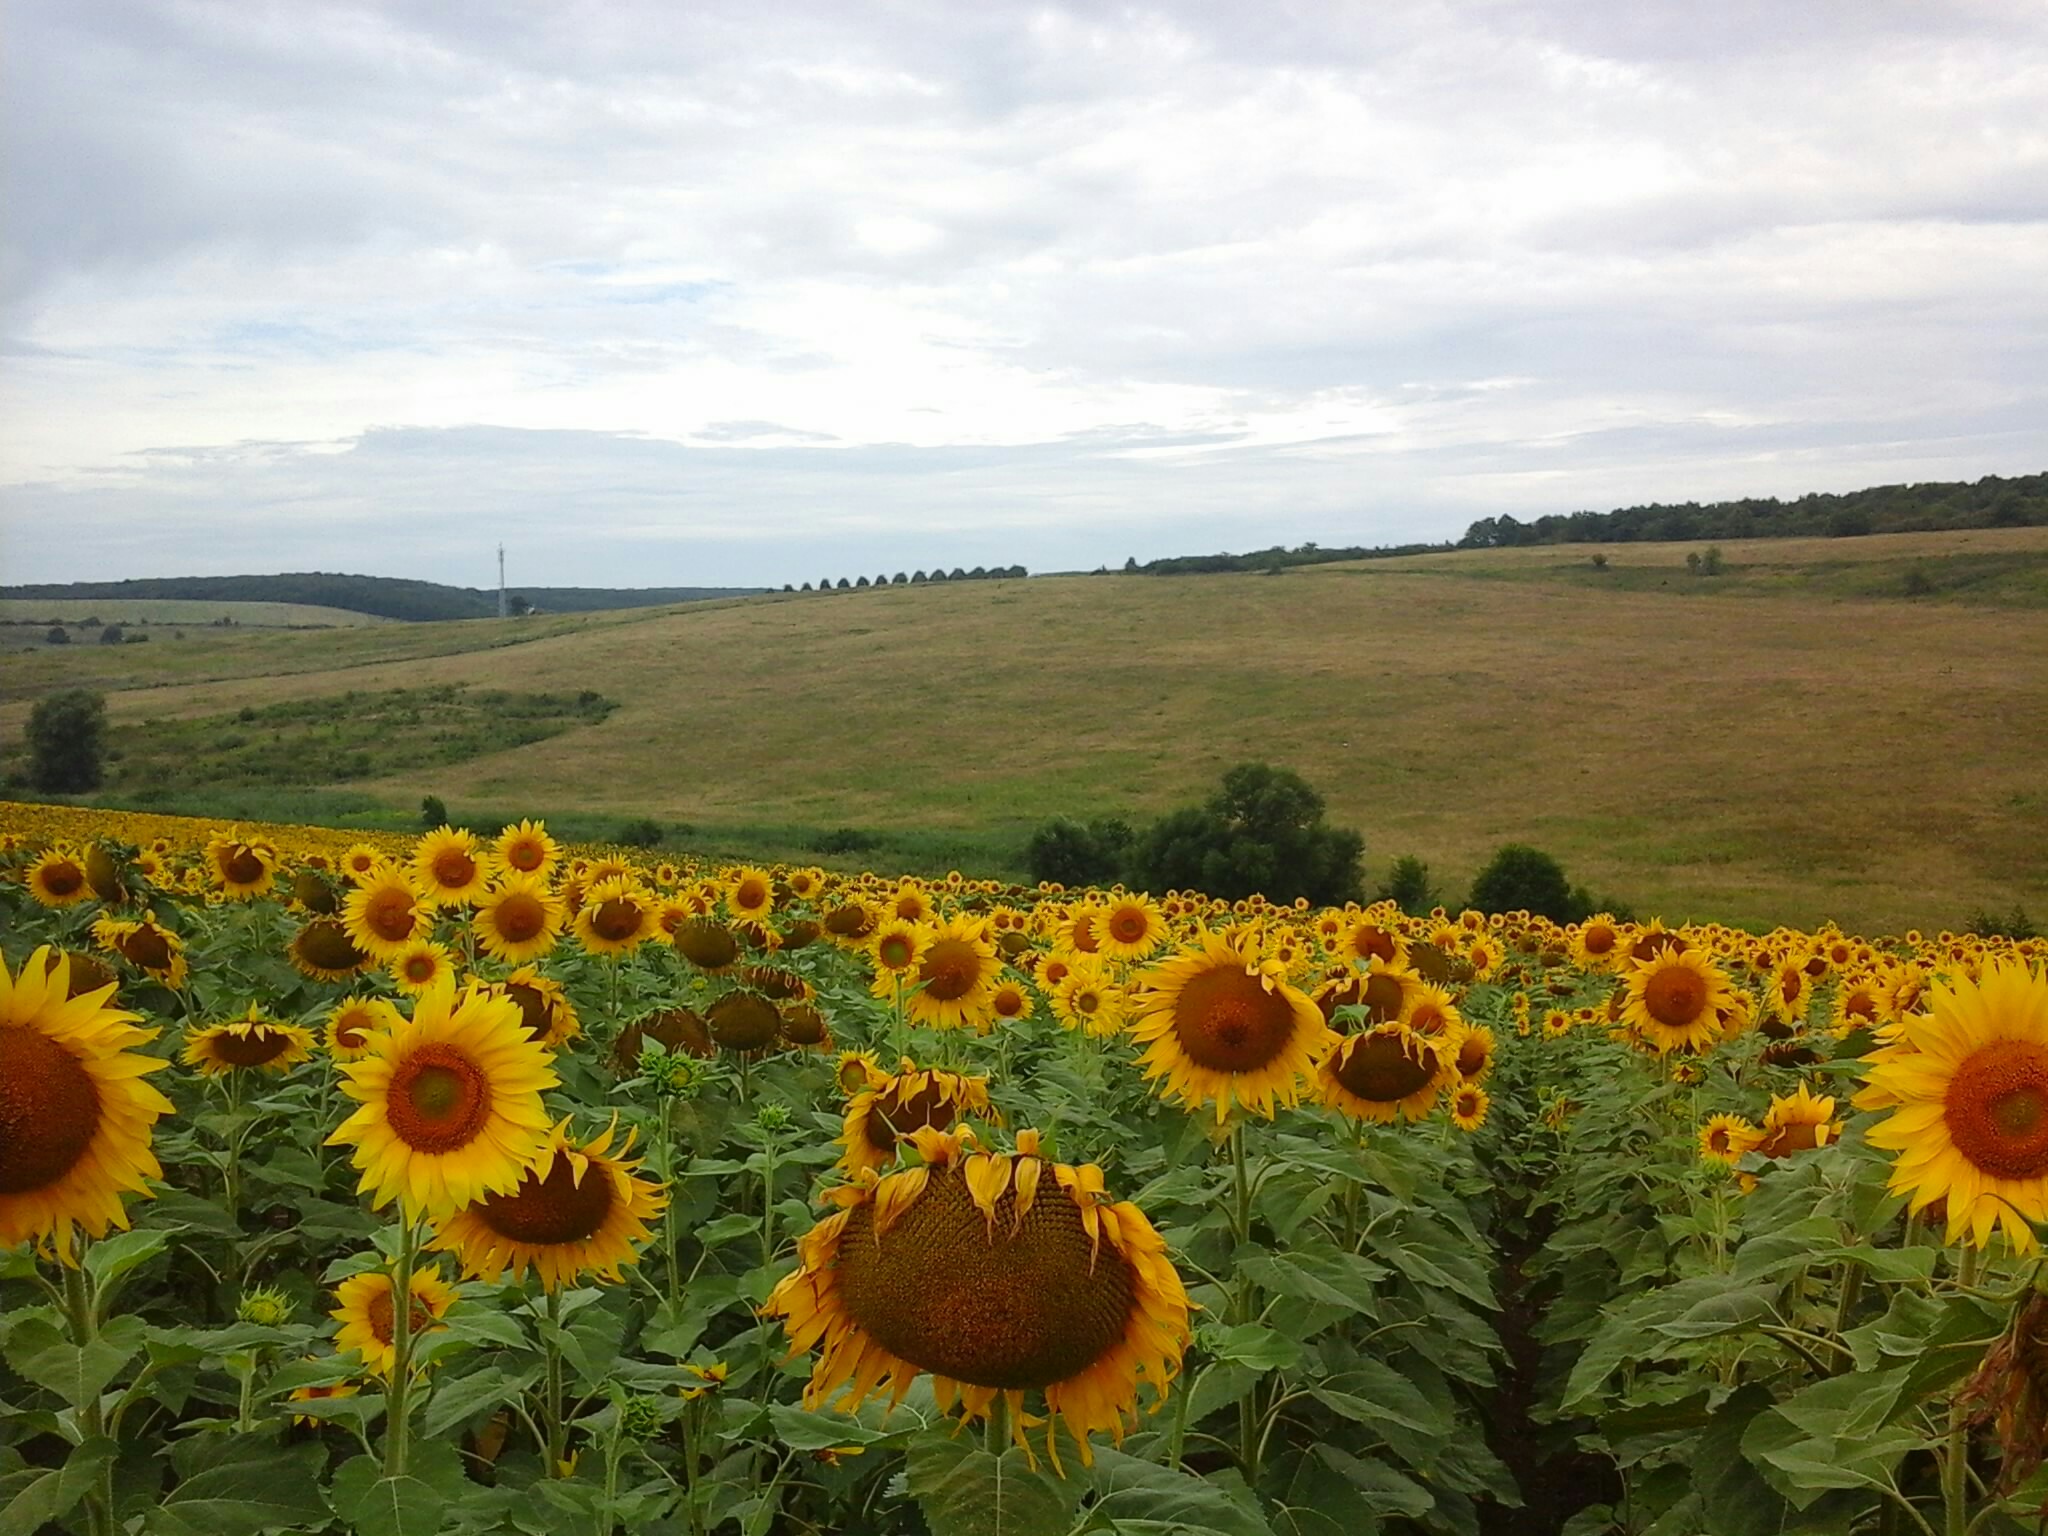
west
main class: Cropland
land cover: Sunflower
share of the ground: > 75 %
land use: Agriculture (excluding fallow land and kitchen gardens)
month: July
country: HU
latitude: 48.4407
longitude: 21.1131
